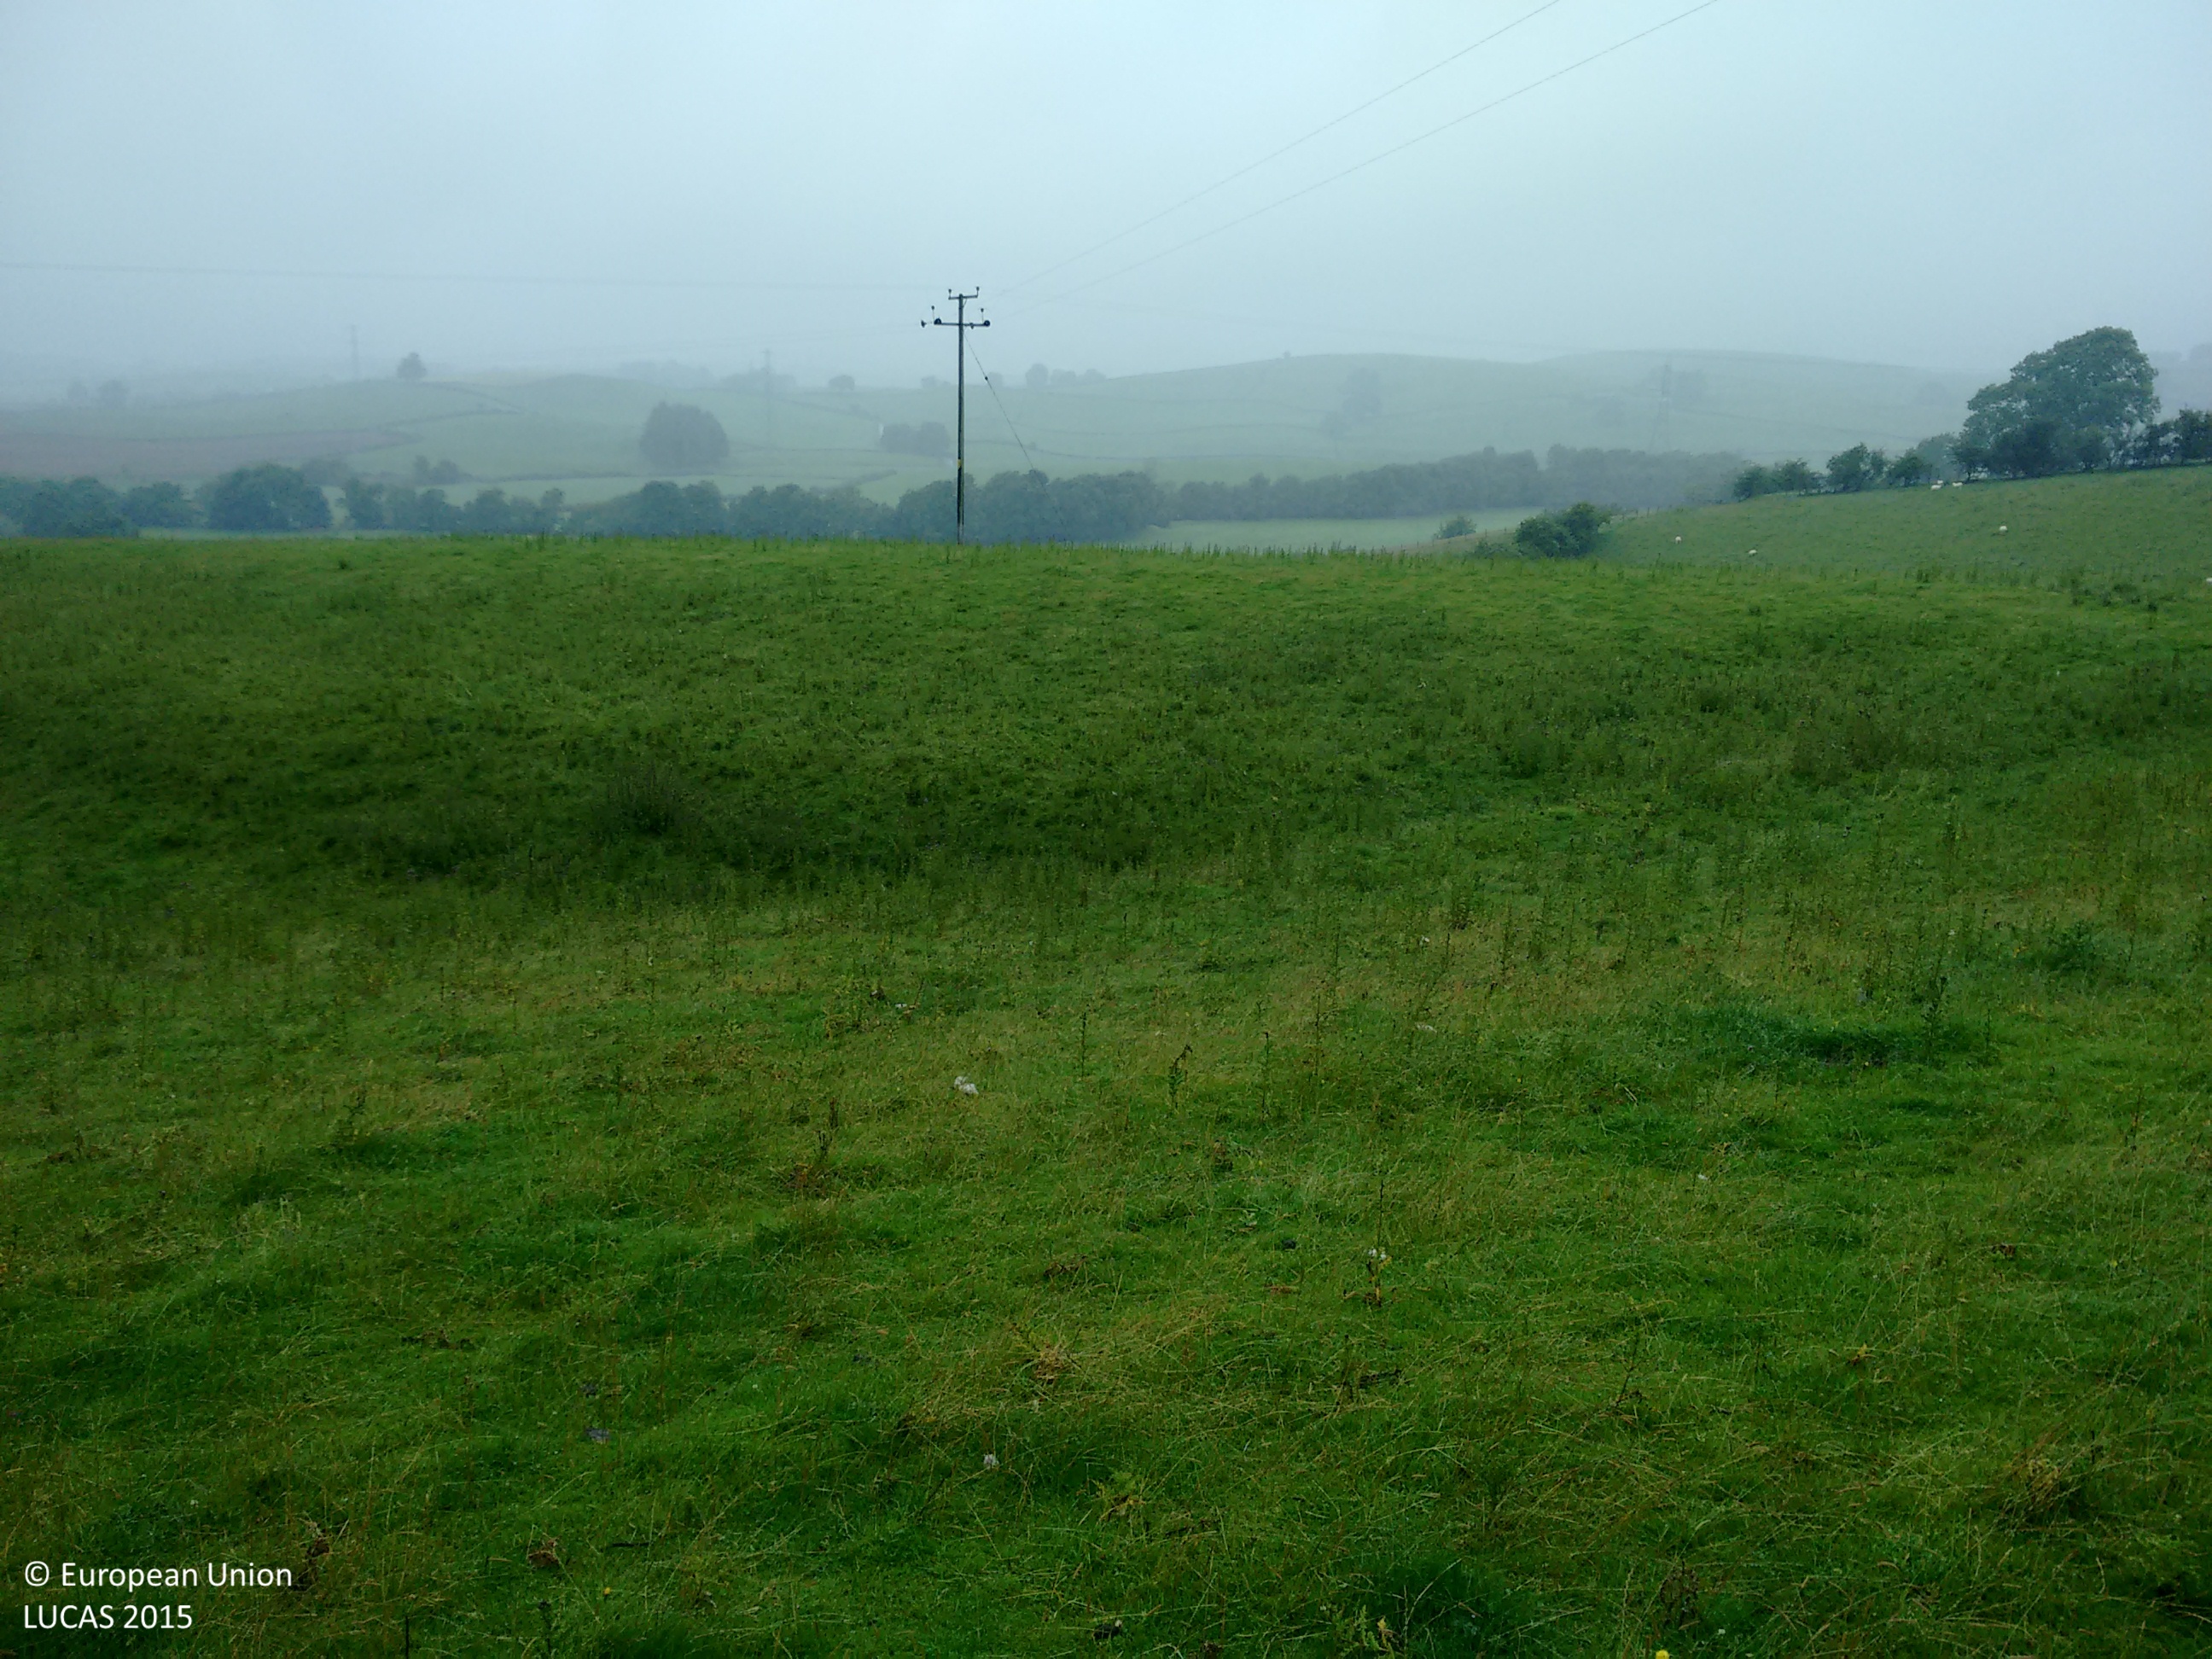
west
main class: Grassland
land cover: Grassland without tree/shrub cover
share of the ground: > 75 %
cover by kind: herbaceous plants 100 %
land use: Agriculture (excluding fallow land and kitchen gardens)
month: August
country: GB
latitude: 54.3894
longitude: -2.6795
